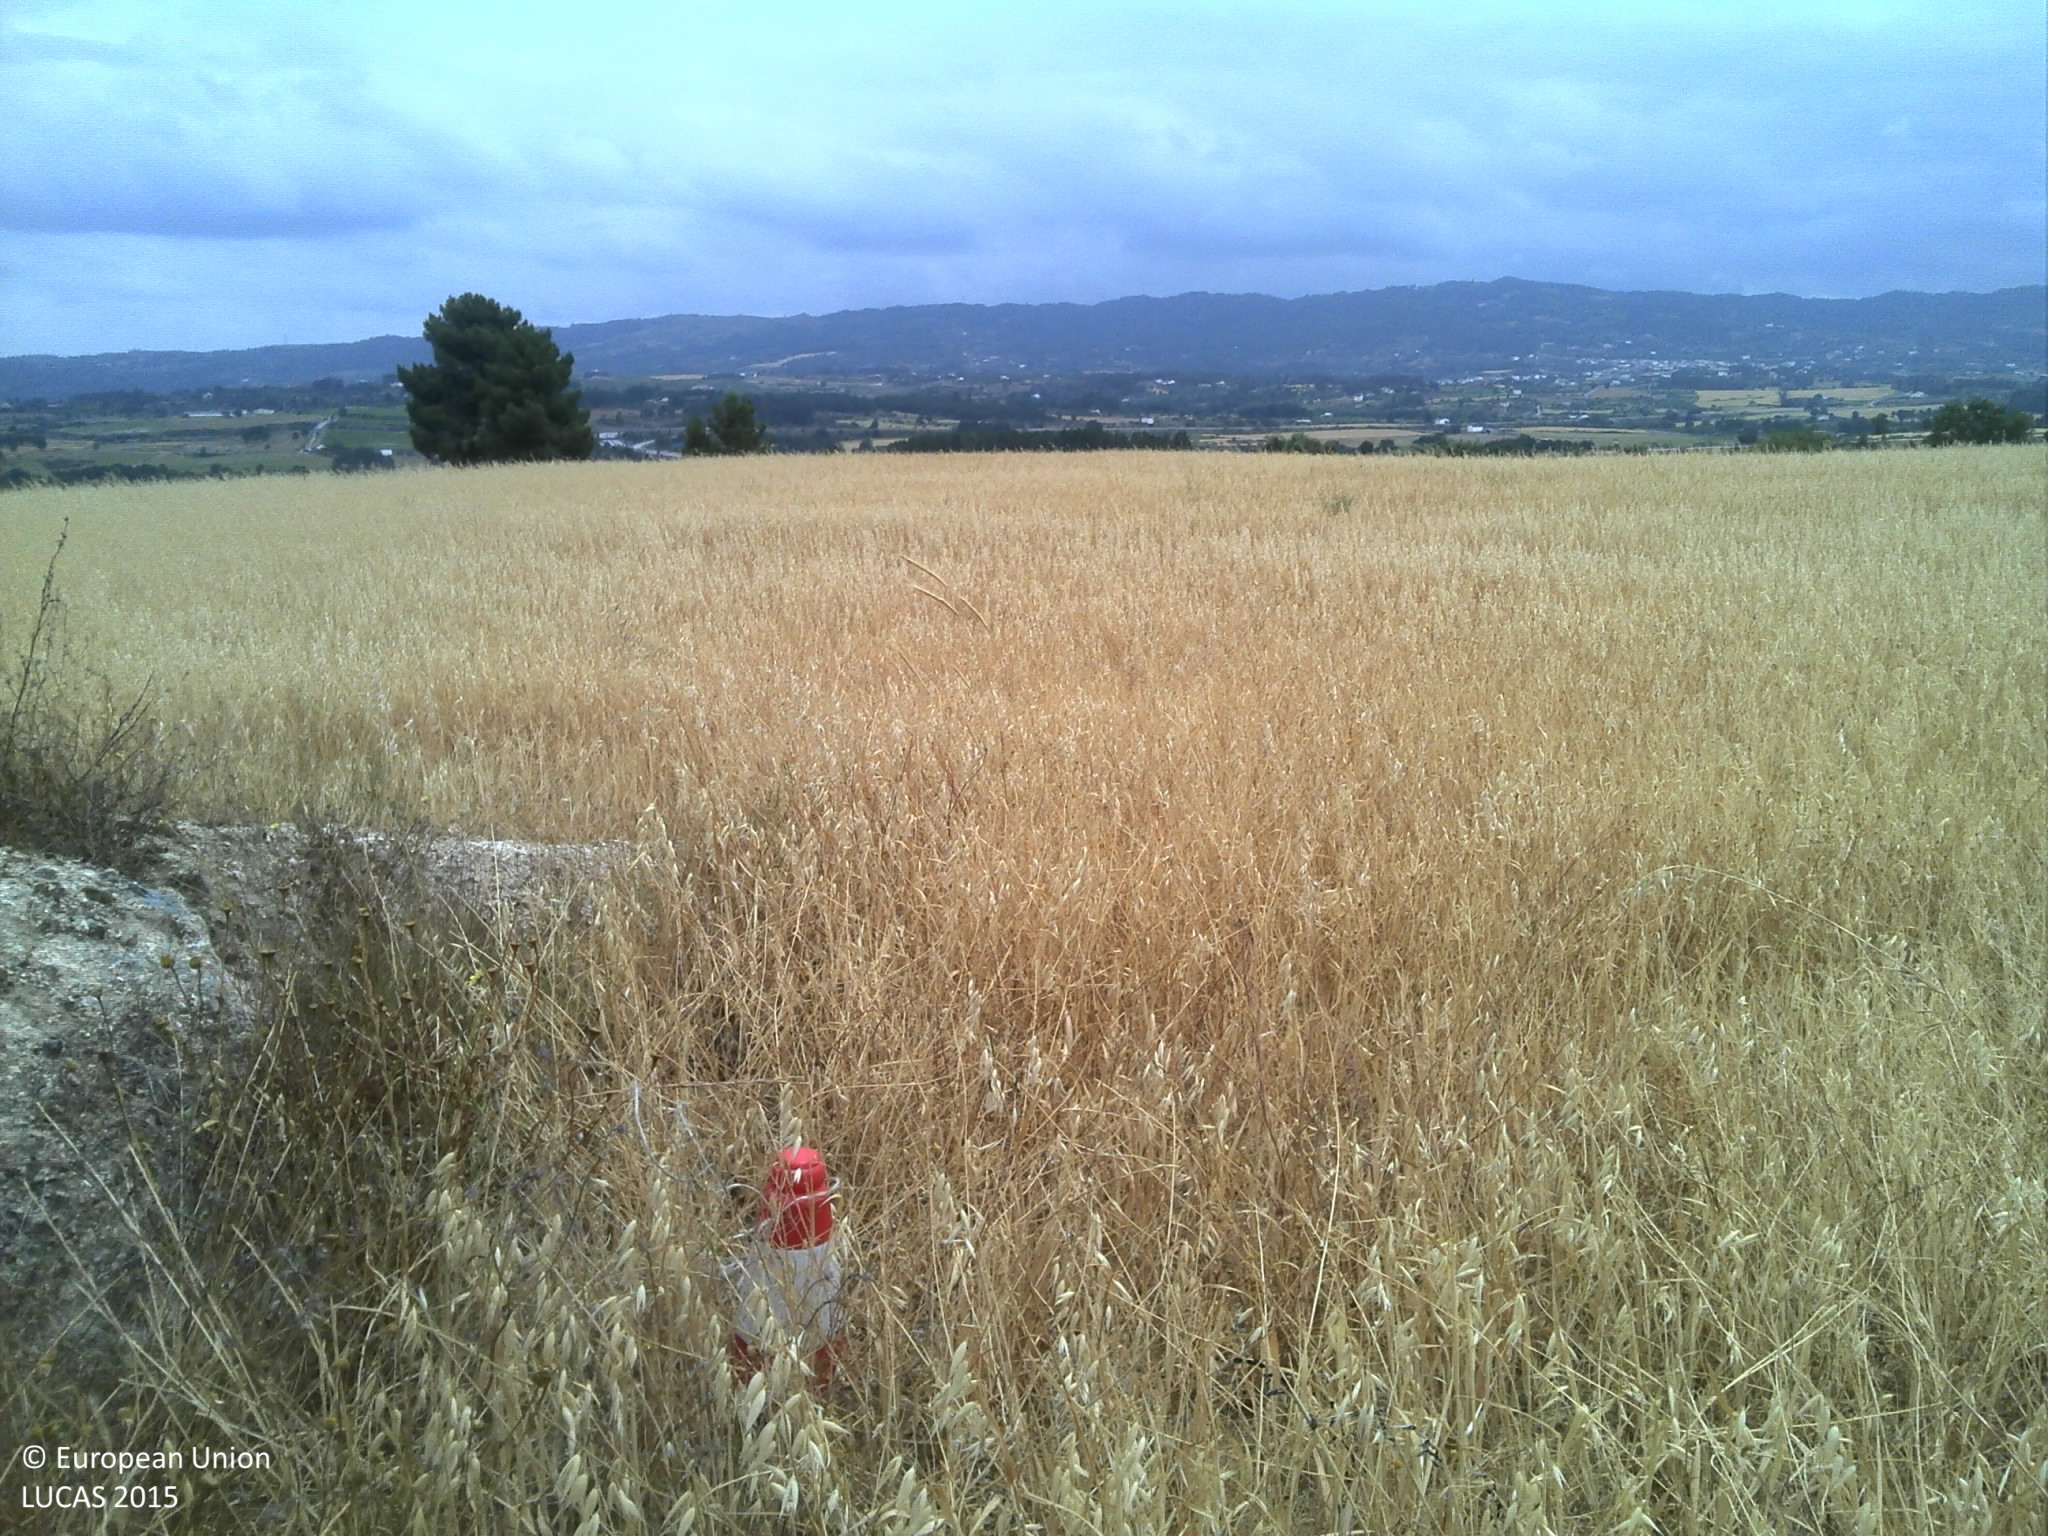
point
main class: Cropland
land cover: Oats
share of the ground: 50 - 75 %
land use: Agriculture (excluding fallow land and kitchen gardens)
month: June
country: PT
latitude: 40.2764
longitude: -7.4532
